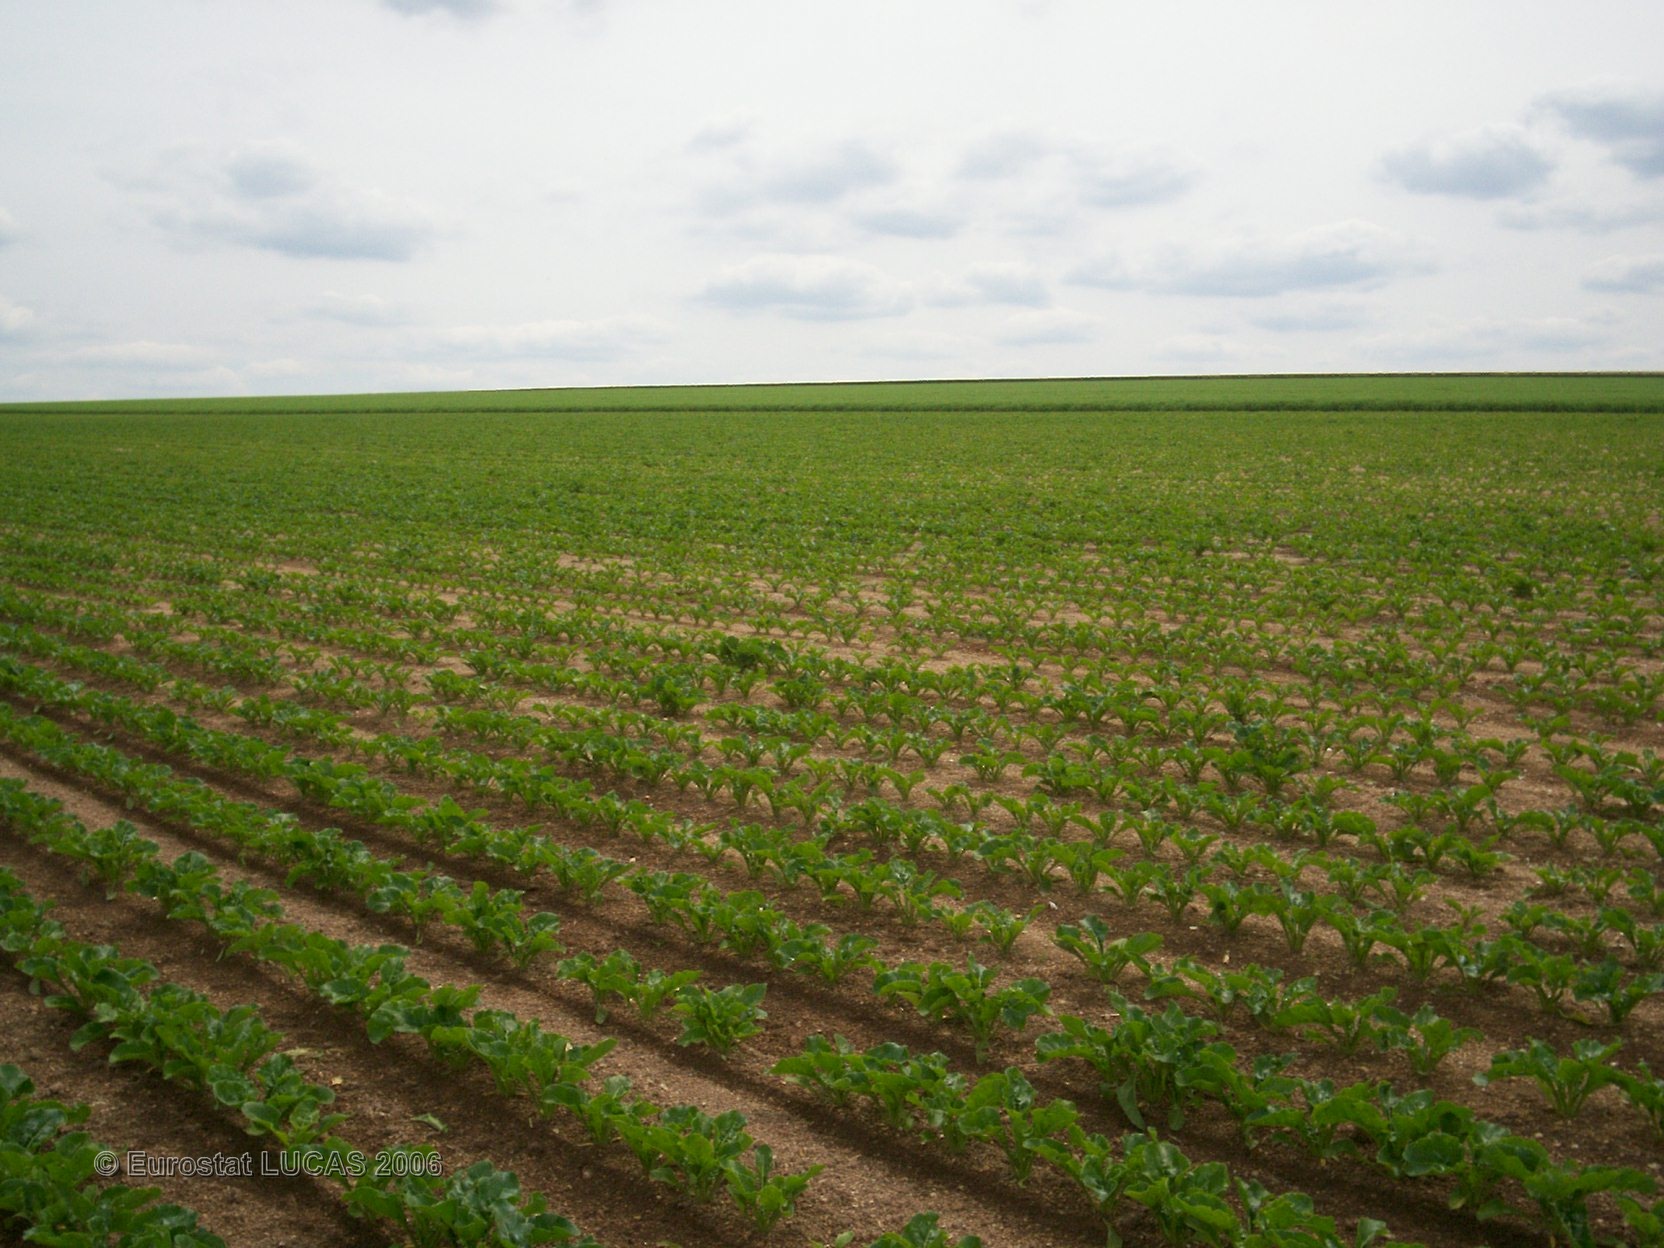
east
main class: Cropland
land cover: Rape and turnip rape
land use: Agriculture (excluding fallow land and kitchen gardens)
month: June
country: FR
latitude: 48.8851
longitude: 4.6103
